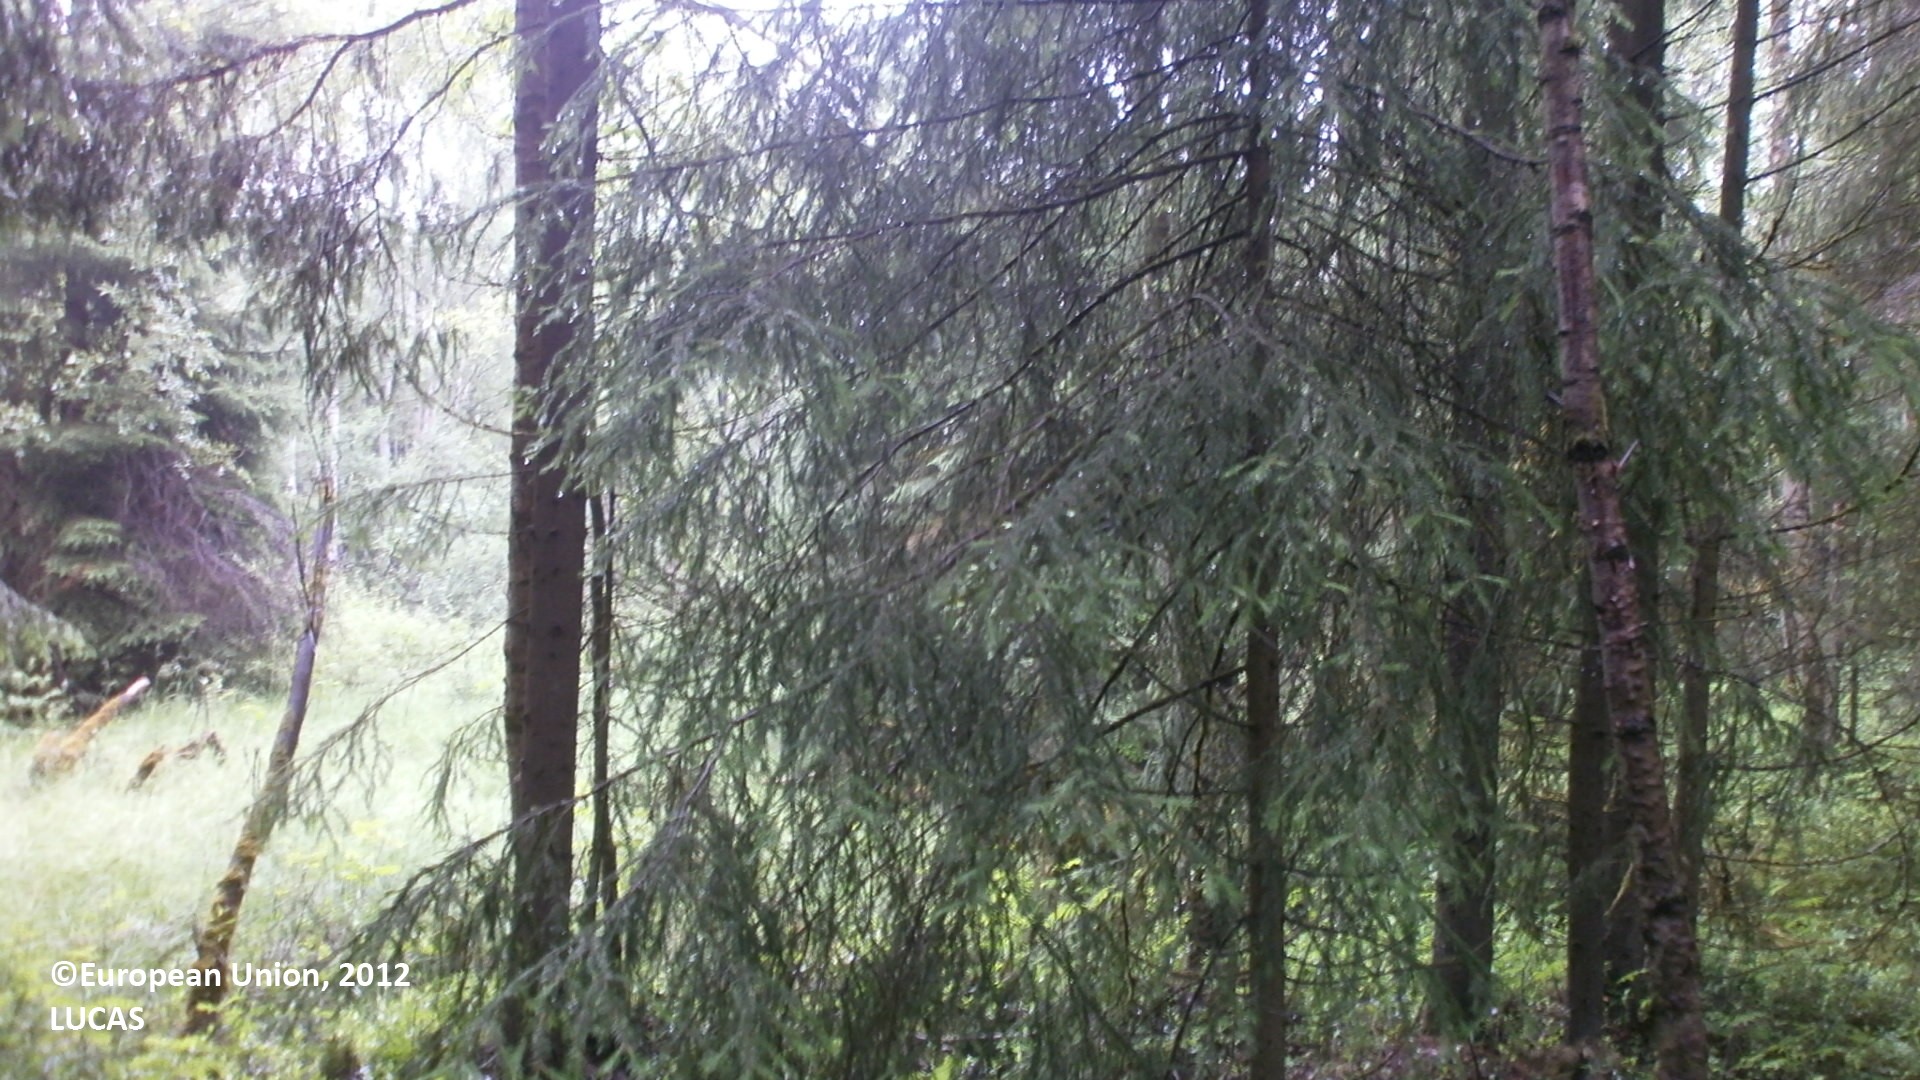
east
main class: Woodland
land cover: Spruce dominated mixed woodland
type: boreal forest
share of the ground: > 75 %
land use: Forestry
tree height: > 5 m
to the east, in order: Spruce dominated mixed woodland; Spruce dominated coniferous woodland; Spruce dominated mixed woodland; Grassland without tree/shrub cover; Spruce dominated mixed woodland; Shrubland with sparse tree cover; Spruce dominated mixed woodland; Tracks; Spruce dominated mixed woodland; Grassland without tree/shrub cover; Spruce dominated mixed woodland; Ditches and canals; Shruby margins; Electric lines; Shruby margins; Paved roads, cycling and walking lanes; Shruby margins; Ditches and canals; Broadleaved woodland; Spruce dominated coniferous woodland
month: July
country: FI
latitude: 64.6537
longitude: 24.4495
